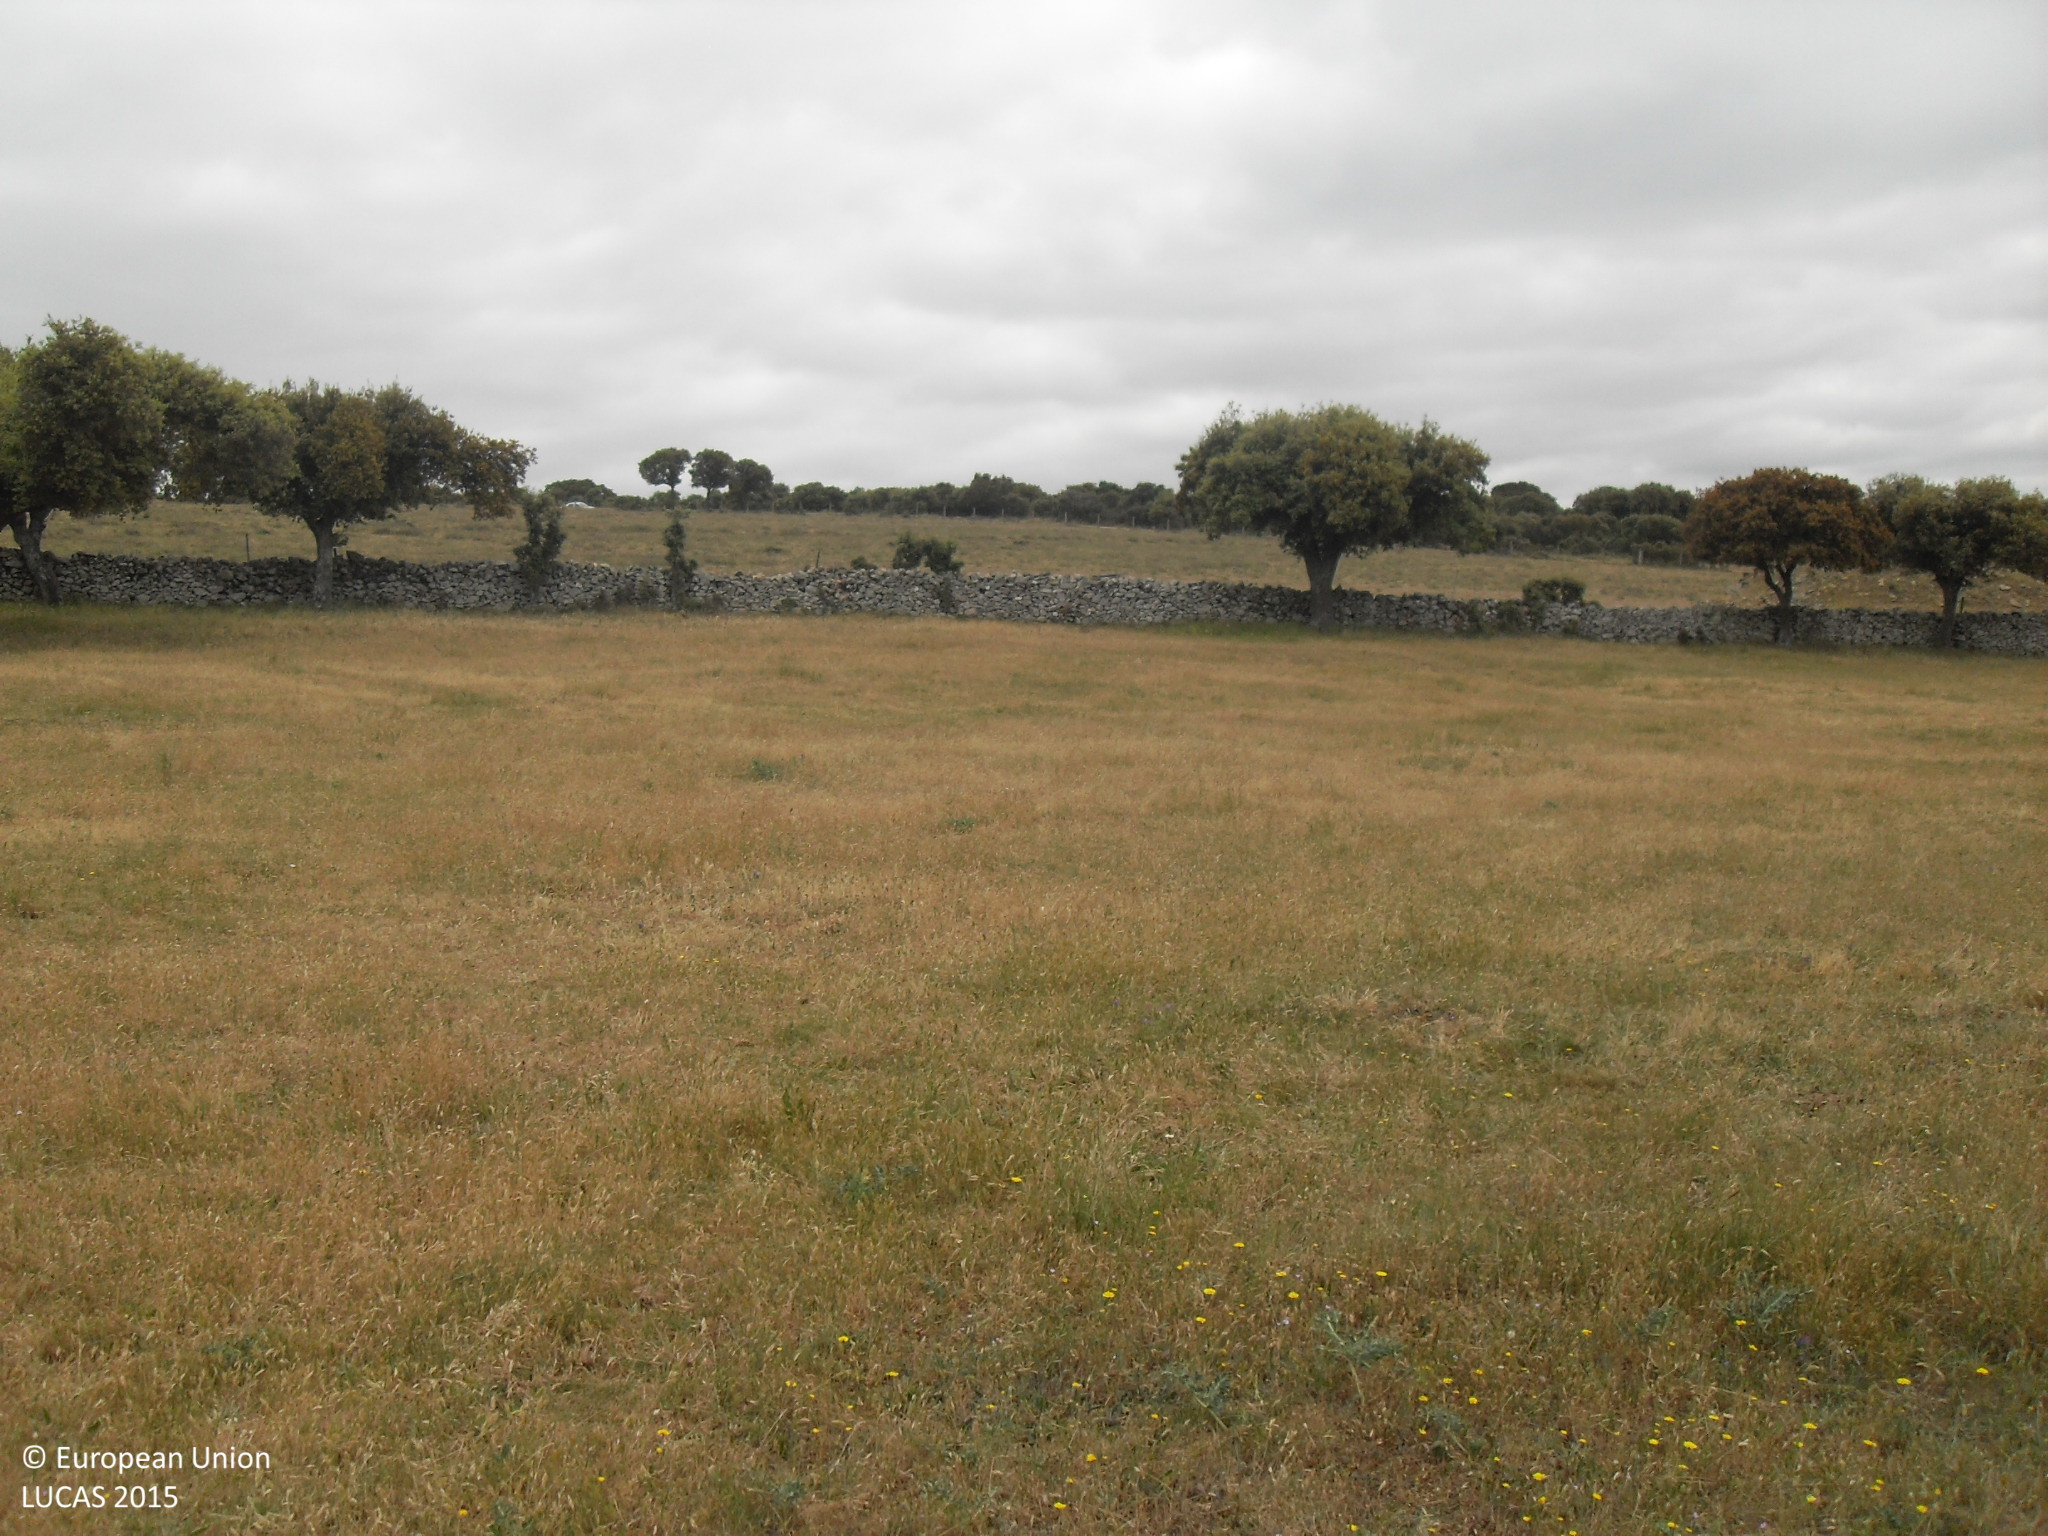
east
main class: Grassland
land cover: Grassland without tree/shrub cover
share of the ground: > 75 %
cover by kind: herbaceous plants 100 %
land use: Agriculture (excluding fallow land and kitchen gardens)
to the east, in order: Grassland without tree/shrub cover; Dry stone walls; Grassland without tree/shrub cover; Tracks; Grassland without tree/shrub cover; Fences; Grass margins; Tracks; Grass margins; Fences; Grassland with sparse tree/shrub cover
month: May
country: ES
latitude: 40.6081
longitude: -5.6127
